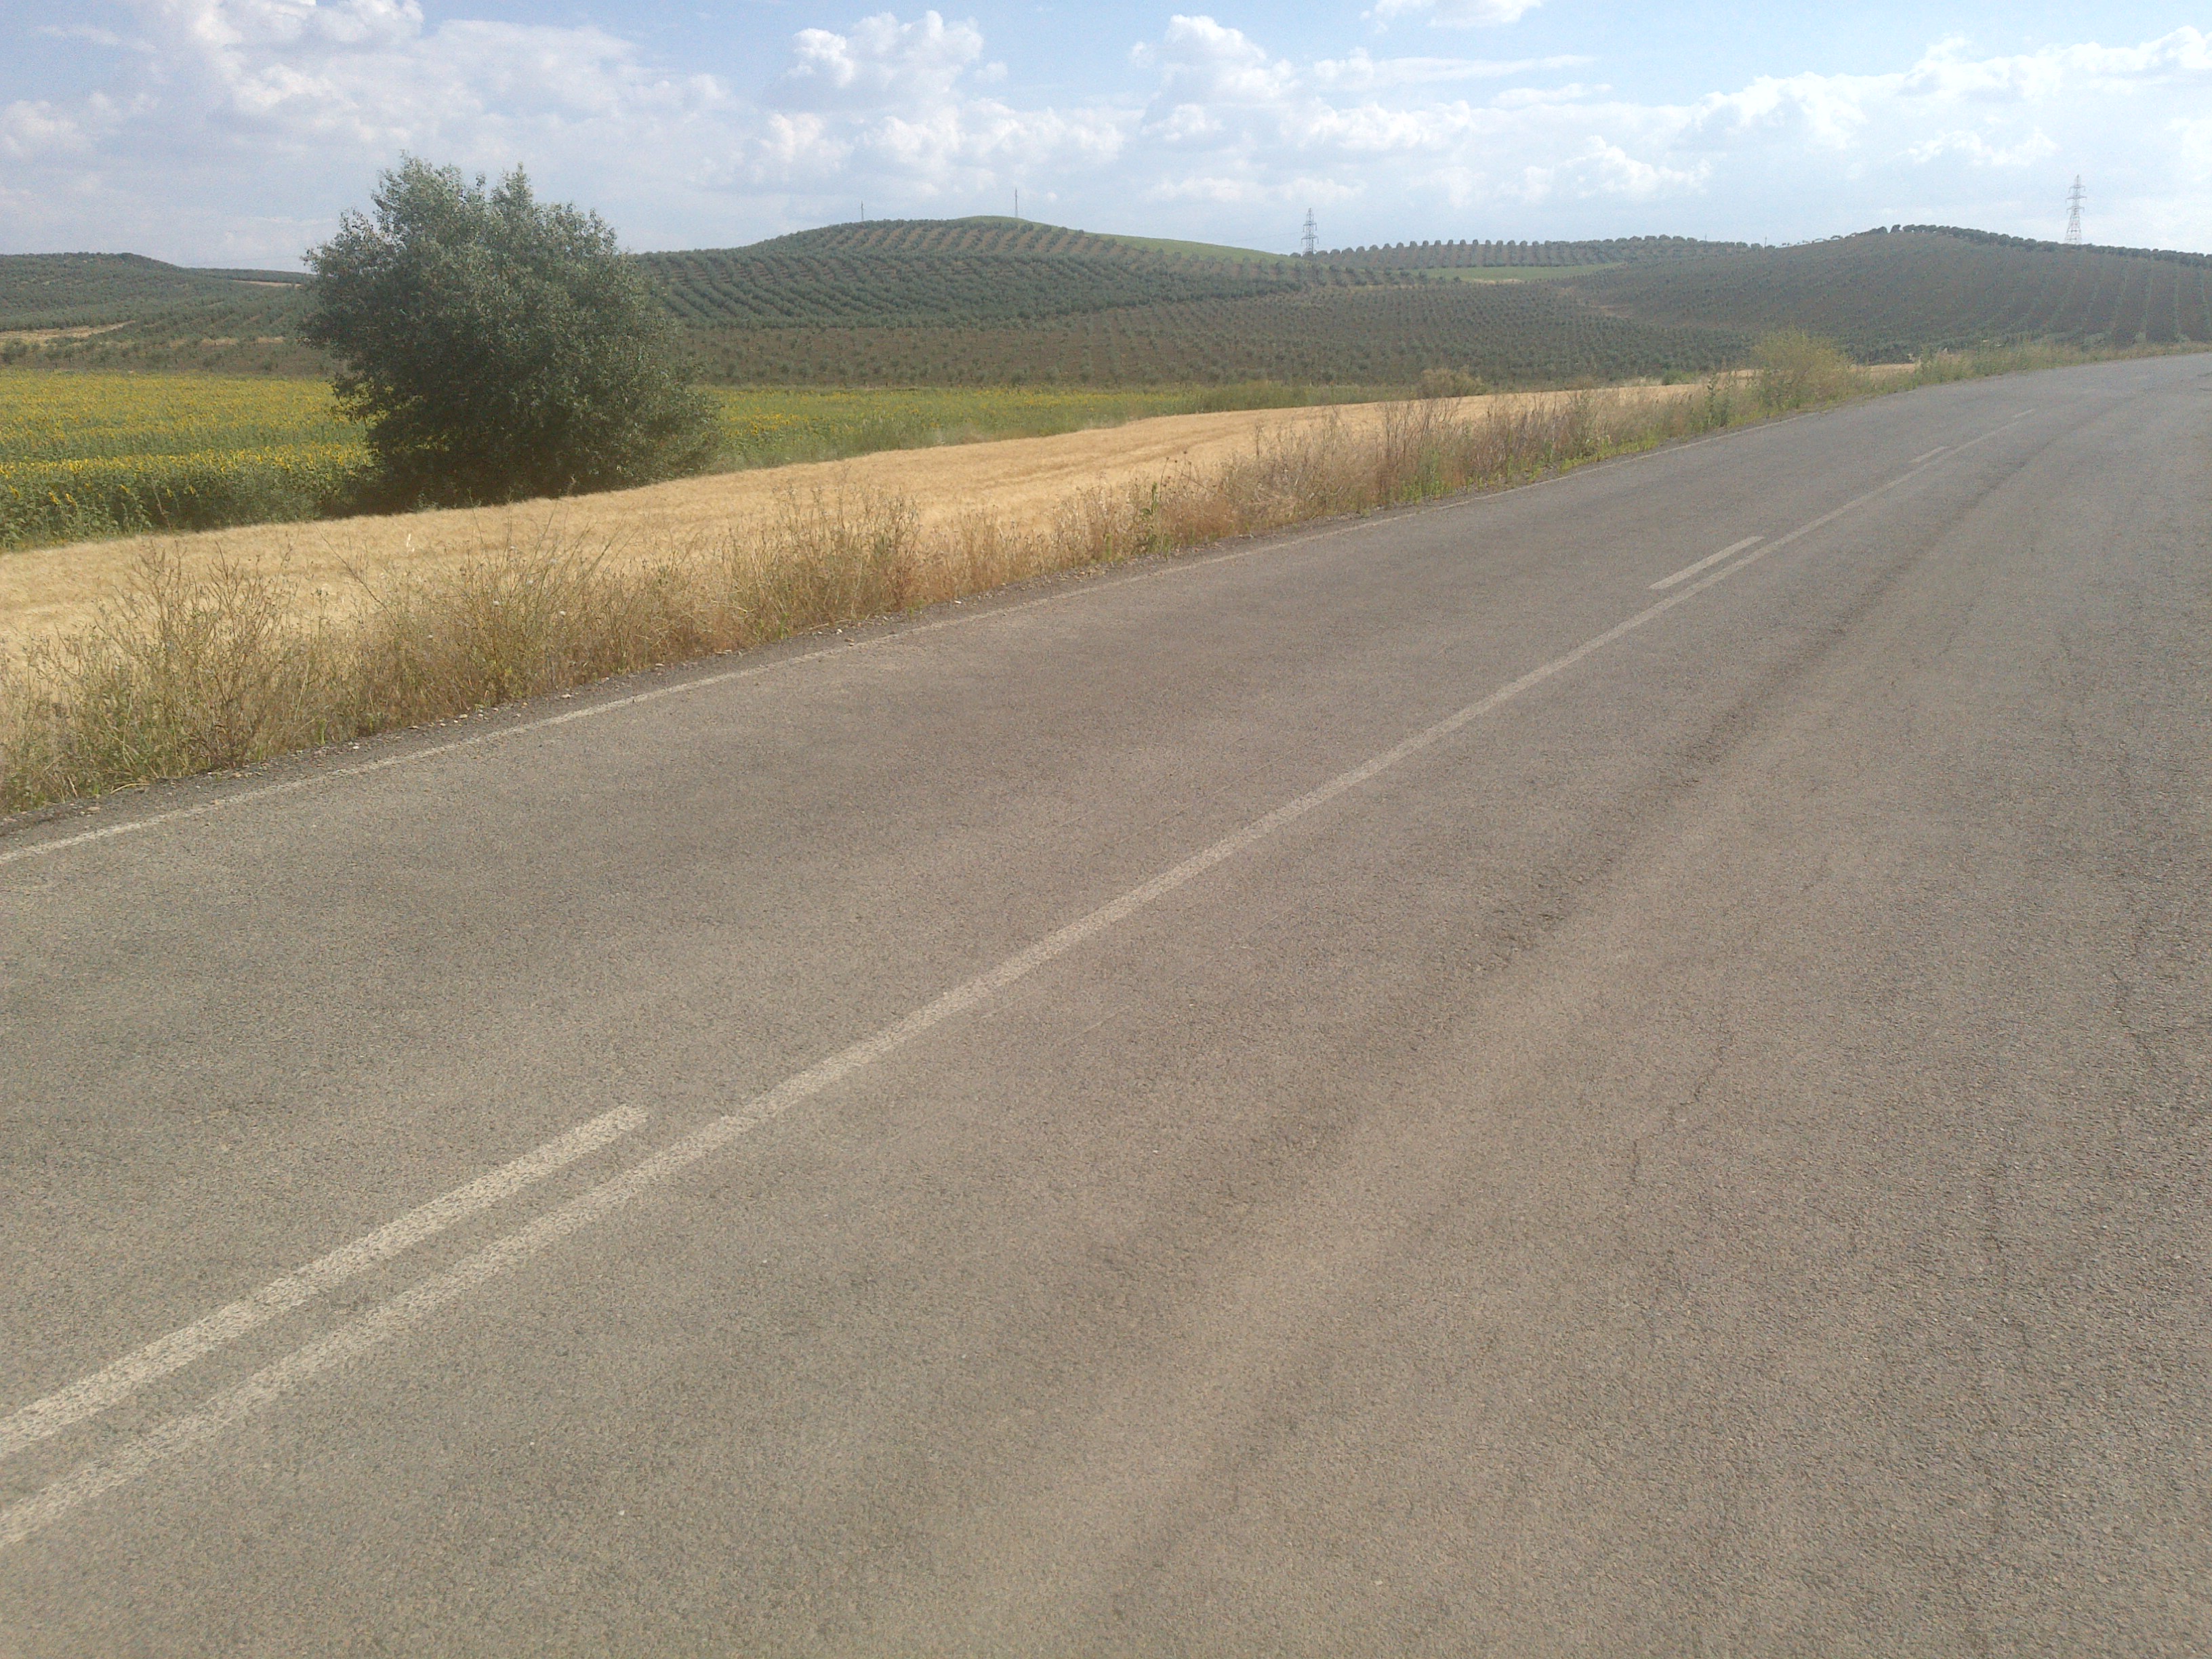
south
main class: Cropland
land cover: Durum wheat
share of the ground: > 75 %
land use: Agriculture (excluding fallow land and kitchen gardens)
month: June
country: ES
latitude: 37.9774
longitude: -4.3433
